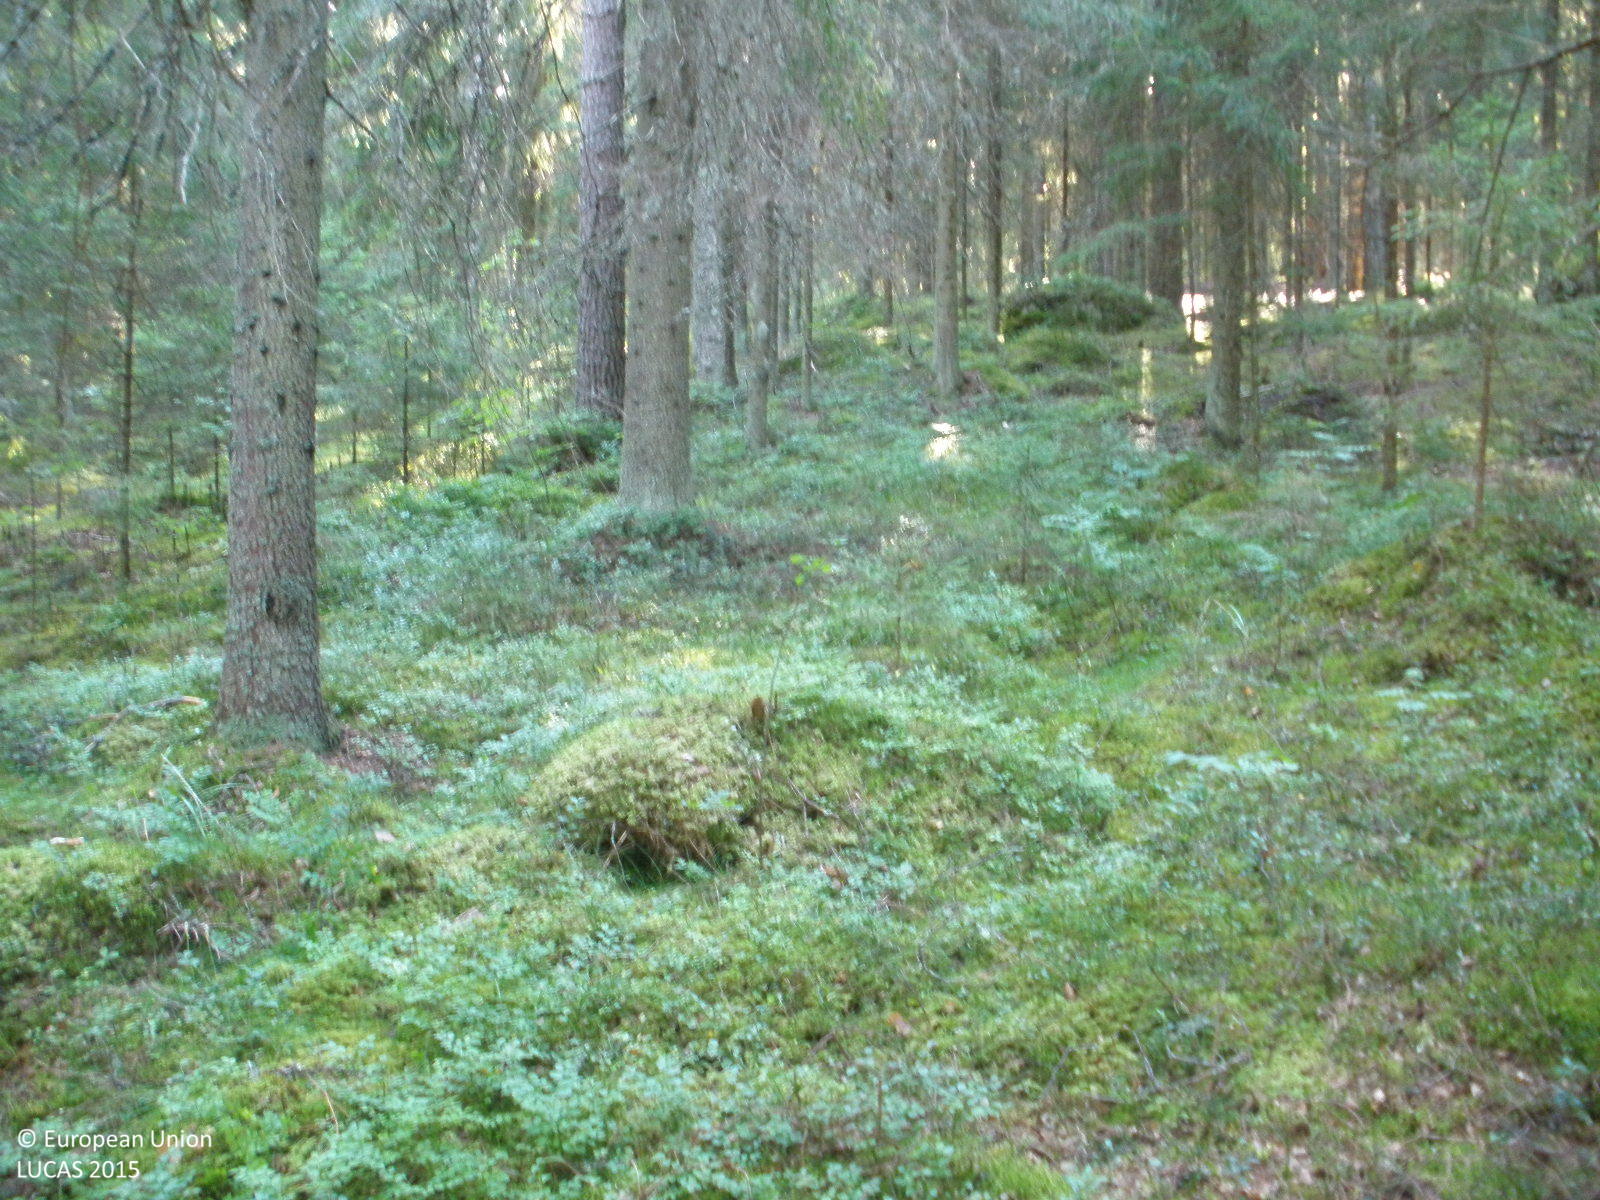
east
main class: Woodland
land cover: Spruce dominated coniferous woodland
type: boreal forest
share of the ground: > 75 %
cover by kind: coniferous forest trees 85 %, shrubs 5 %, herbaceous plants 5 %, lichens and mosses 5 %
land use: Forestry
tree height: > 5 m
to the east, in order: Spruce dominated coniferous woodland; Tracks; Spruce dominated coniferous woodland; Tracks; Spruce dominated coniferous woodland; Ditches and canals; Grass margins; Barley
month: August
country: FI
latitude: 60.9276
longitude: 24.8892
